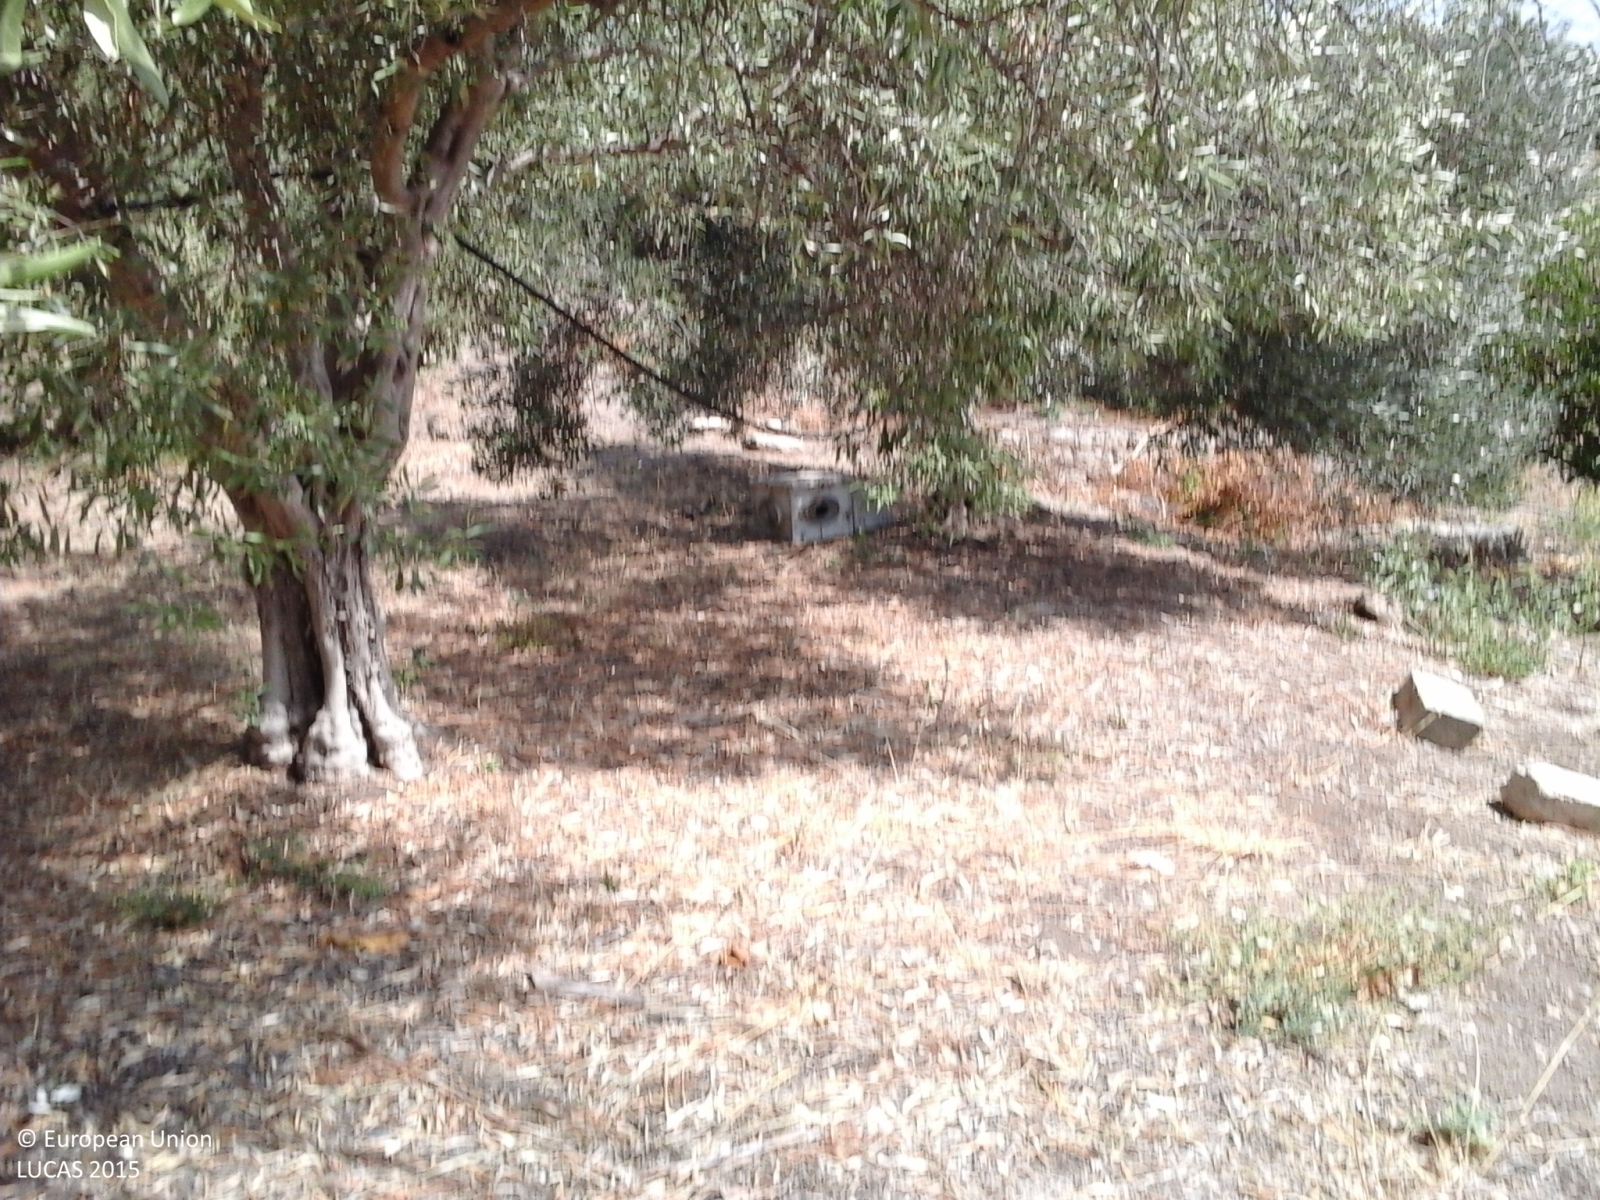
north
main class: Cropland
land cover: Olive groves
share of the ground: > 75 %
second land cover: Spontaneously vegetated surfaces
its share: > 75 %
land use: Agriculture (excluding fallow land and kitchen gardens)
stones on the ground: < 10 %
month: August
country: IT
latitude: 37.2976
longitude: 14.8261
